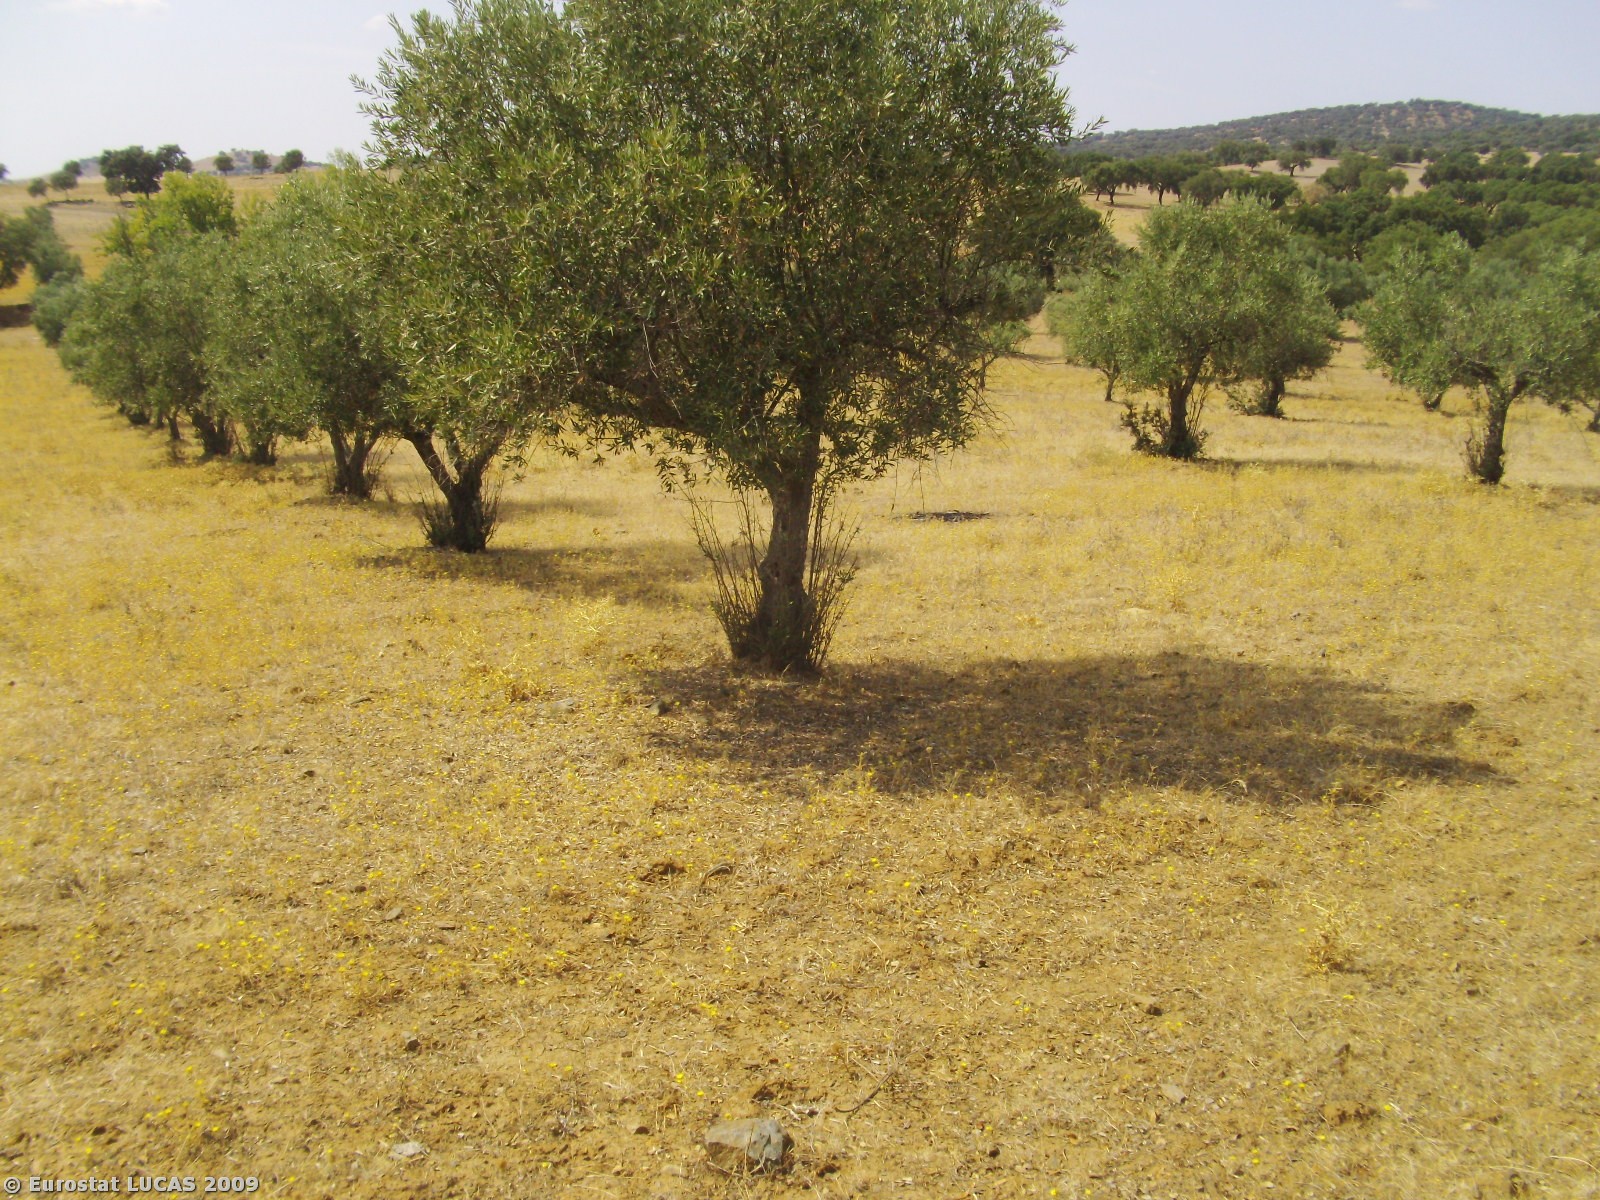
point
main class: Cropland
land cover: Olive groves
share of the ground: 50 - 75 %
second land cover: Spontaneously vegetated surfaces
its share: 50 - 75 %
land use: Agriculture (excluding fallow land and kitchen gardens)
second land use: Fallow land
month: August
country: PT
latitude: 38.3436
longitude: -7.9187
